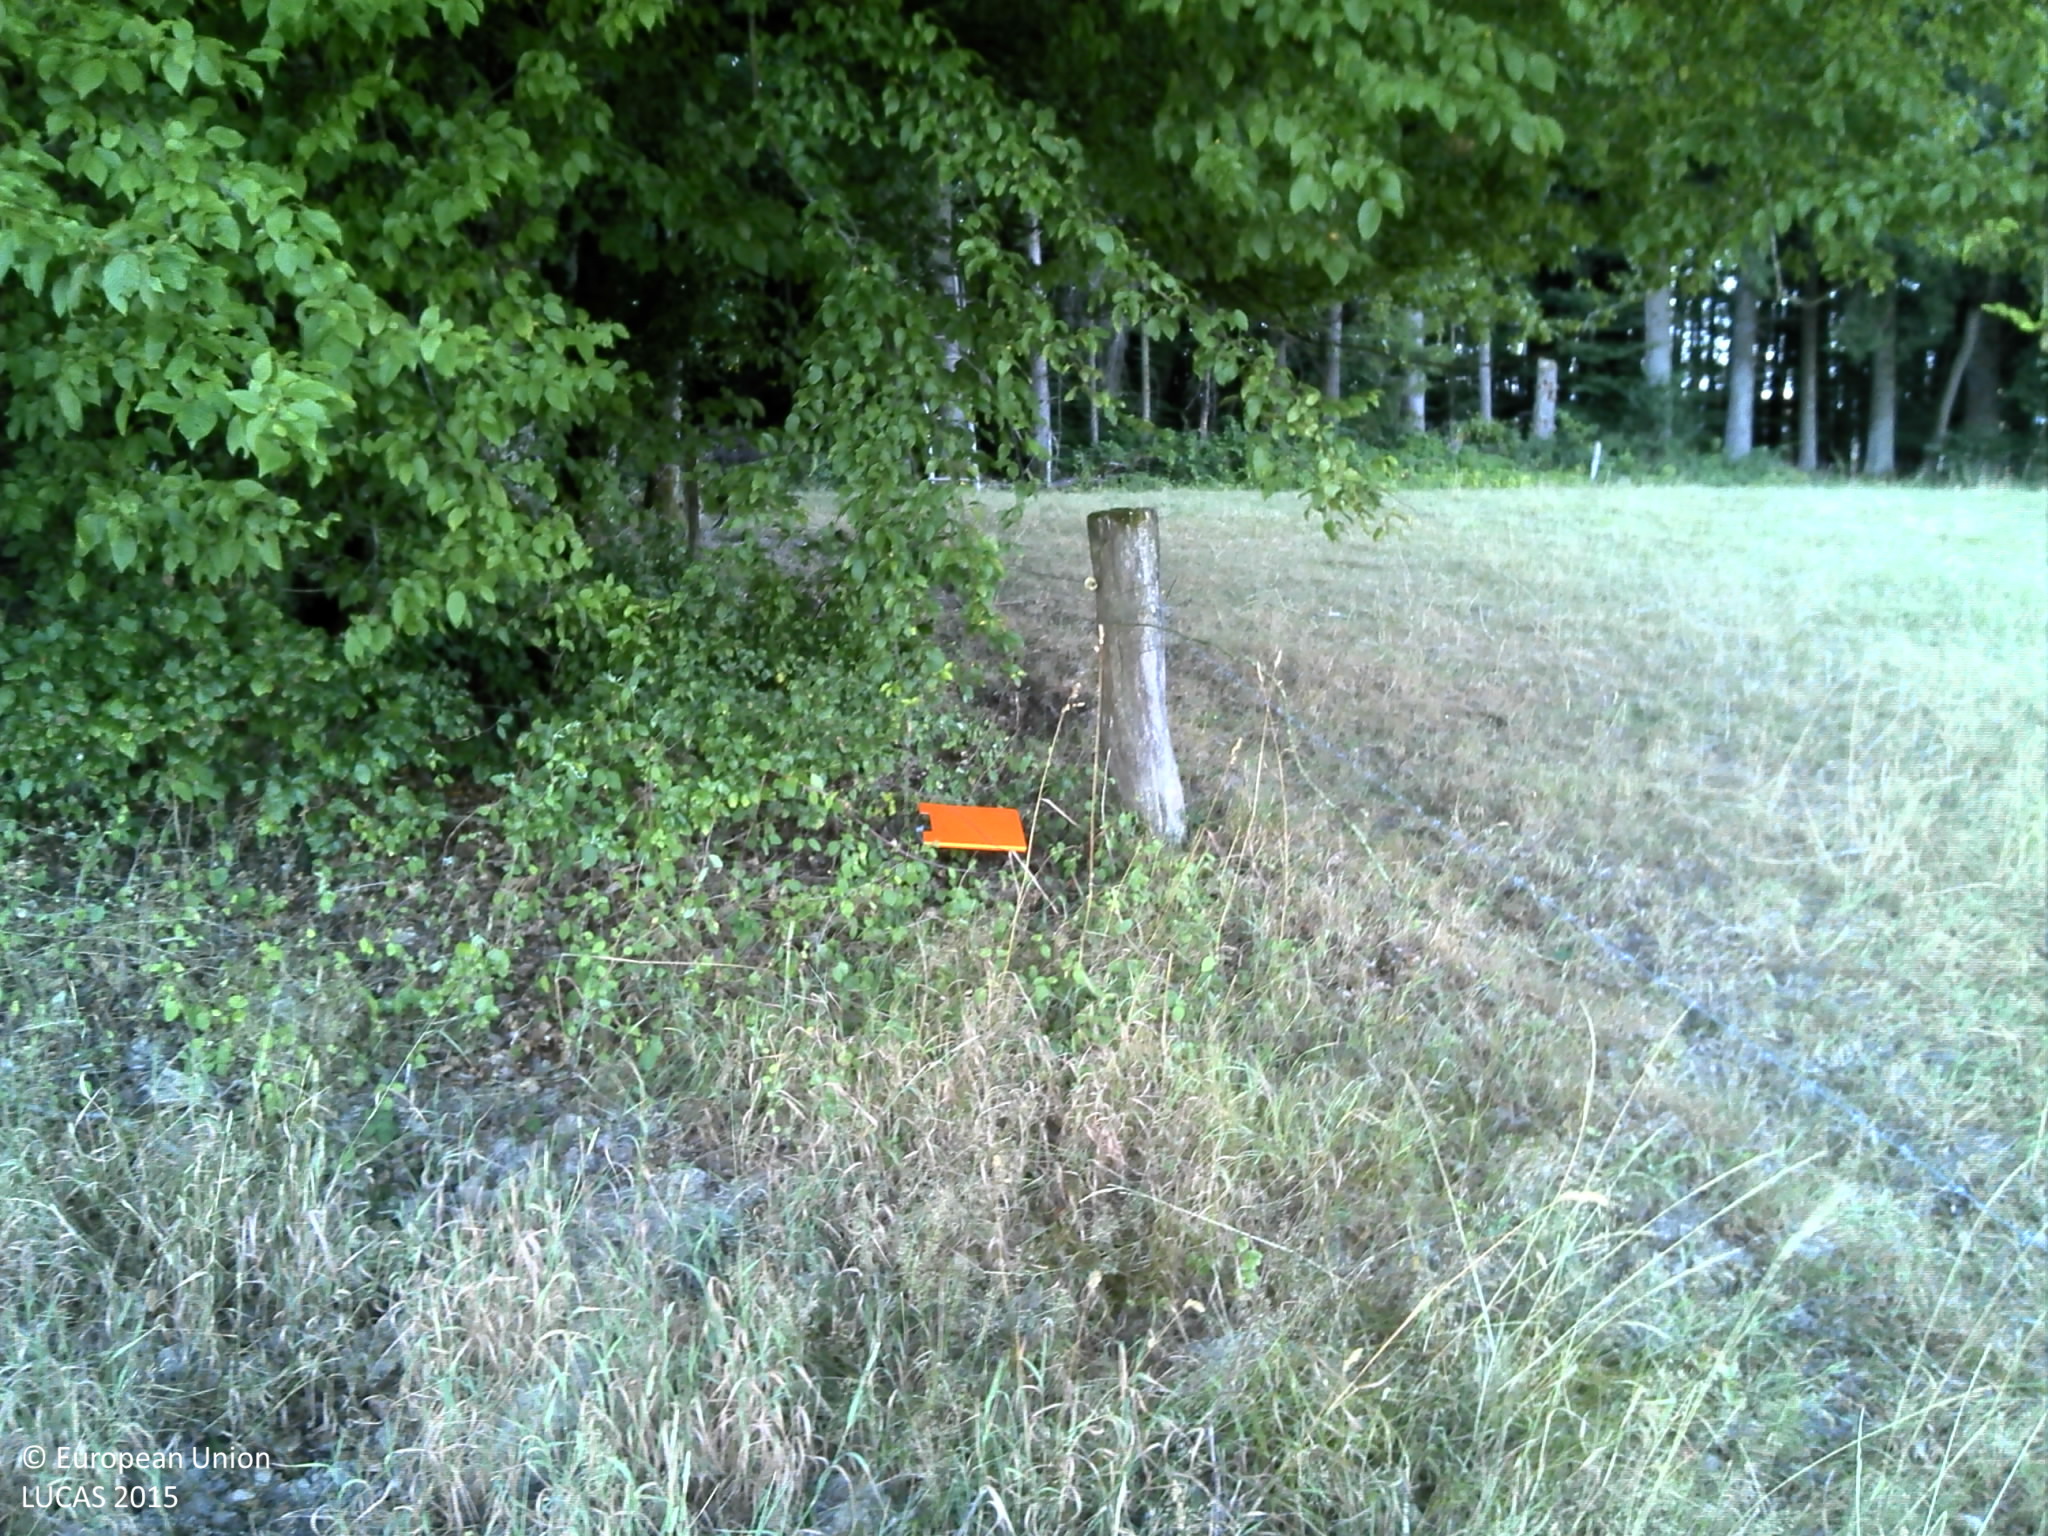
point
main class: Cropland
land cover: Oats
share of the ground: < 10 %
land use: Agriculture (excluding fallow land and kitchen gardens)
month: July
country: FR
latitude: 48.0160
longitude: 6.2603
